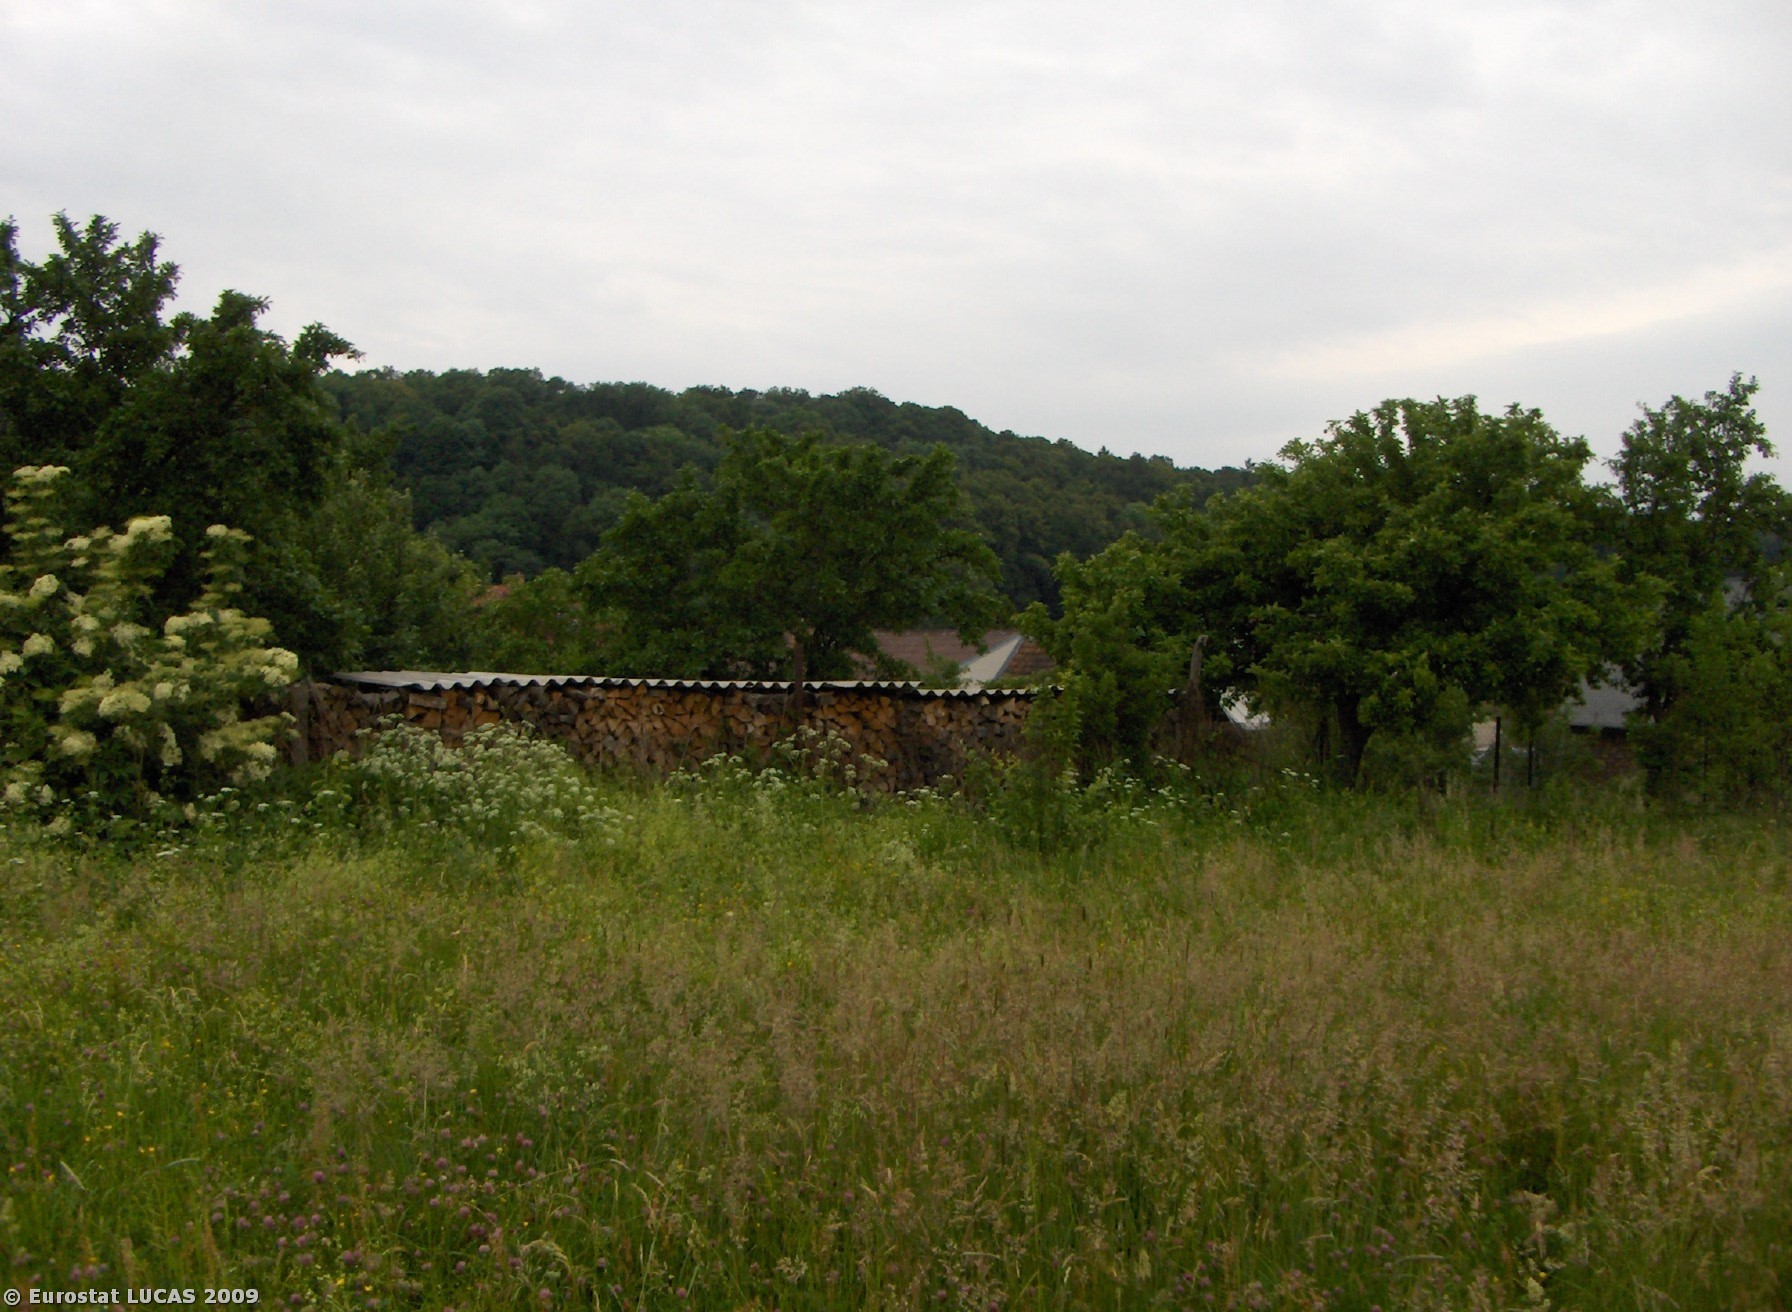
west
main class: Grassland
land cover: Grassland without tree/shrub cover
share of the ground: > 75 %
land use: Agriculture (excluding fallow land and kitchen gardens)
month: May
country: CZ
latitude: 49.0528
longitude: 14.4482
